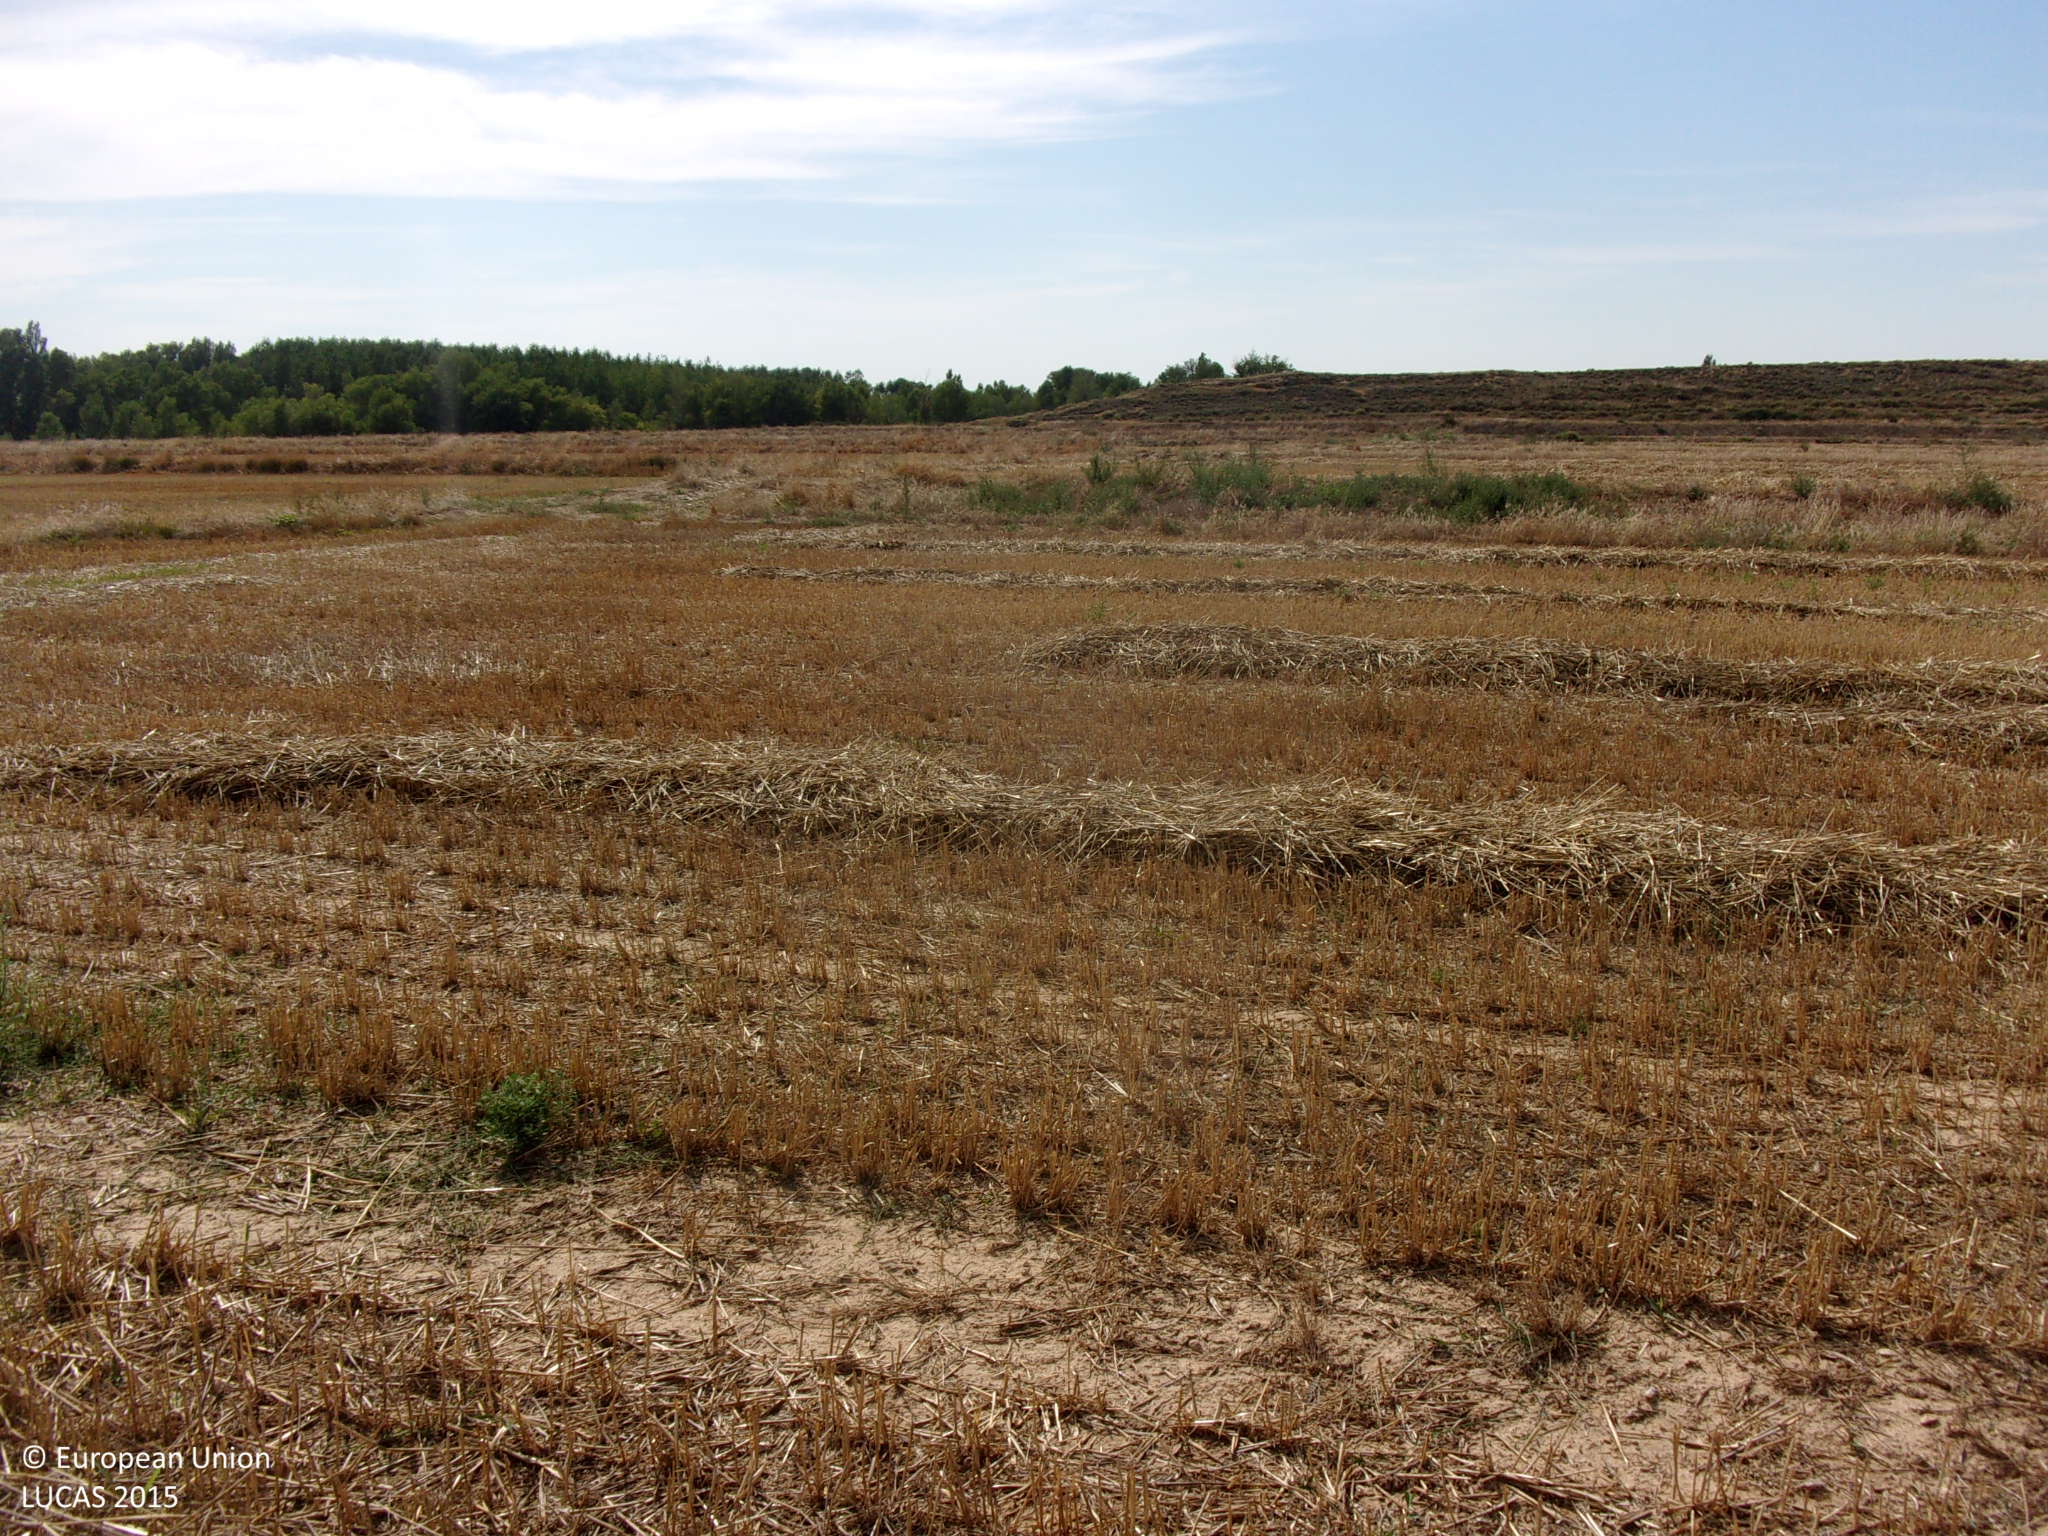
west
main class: Cropland
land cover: Common wheat
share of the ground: < 10 %
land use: Agriculture (excluding fallow land and kitchen gardens)
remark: Harvested field
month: August
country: ES
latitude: 42.1994
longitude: -1.1587
